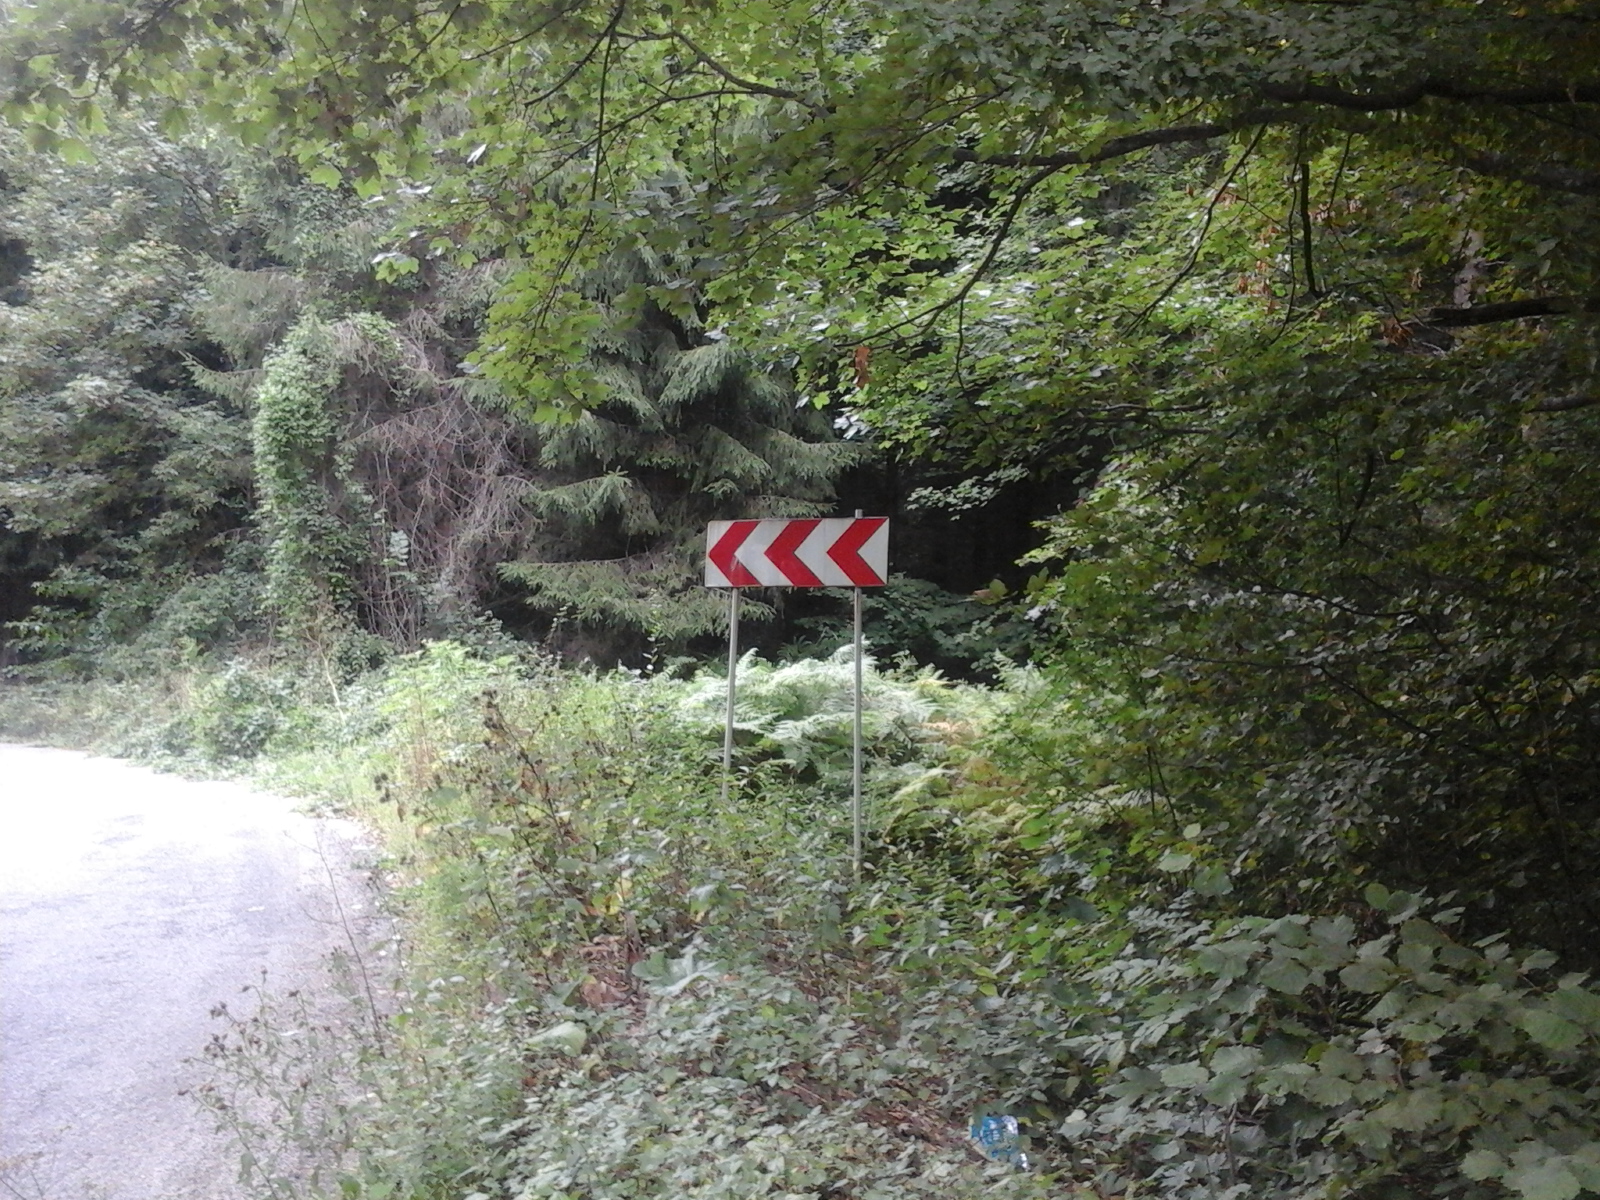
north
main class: Woodland
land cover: Broadleaved woodland
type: beech forest
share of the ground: > 75 %
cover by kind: broadleaved forest trees 100 %
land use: Forestry
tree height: > 5 m
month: August
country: RO
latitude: 45.1412
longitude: 21.8742
